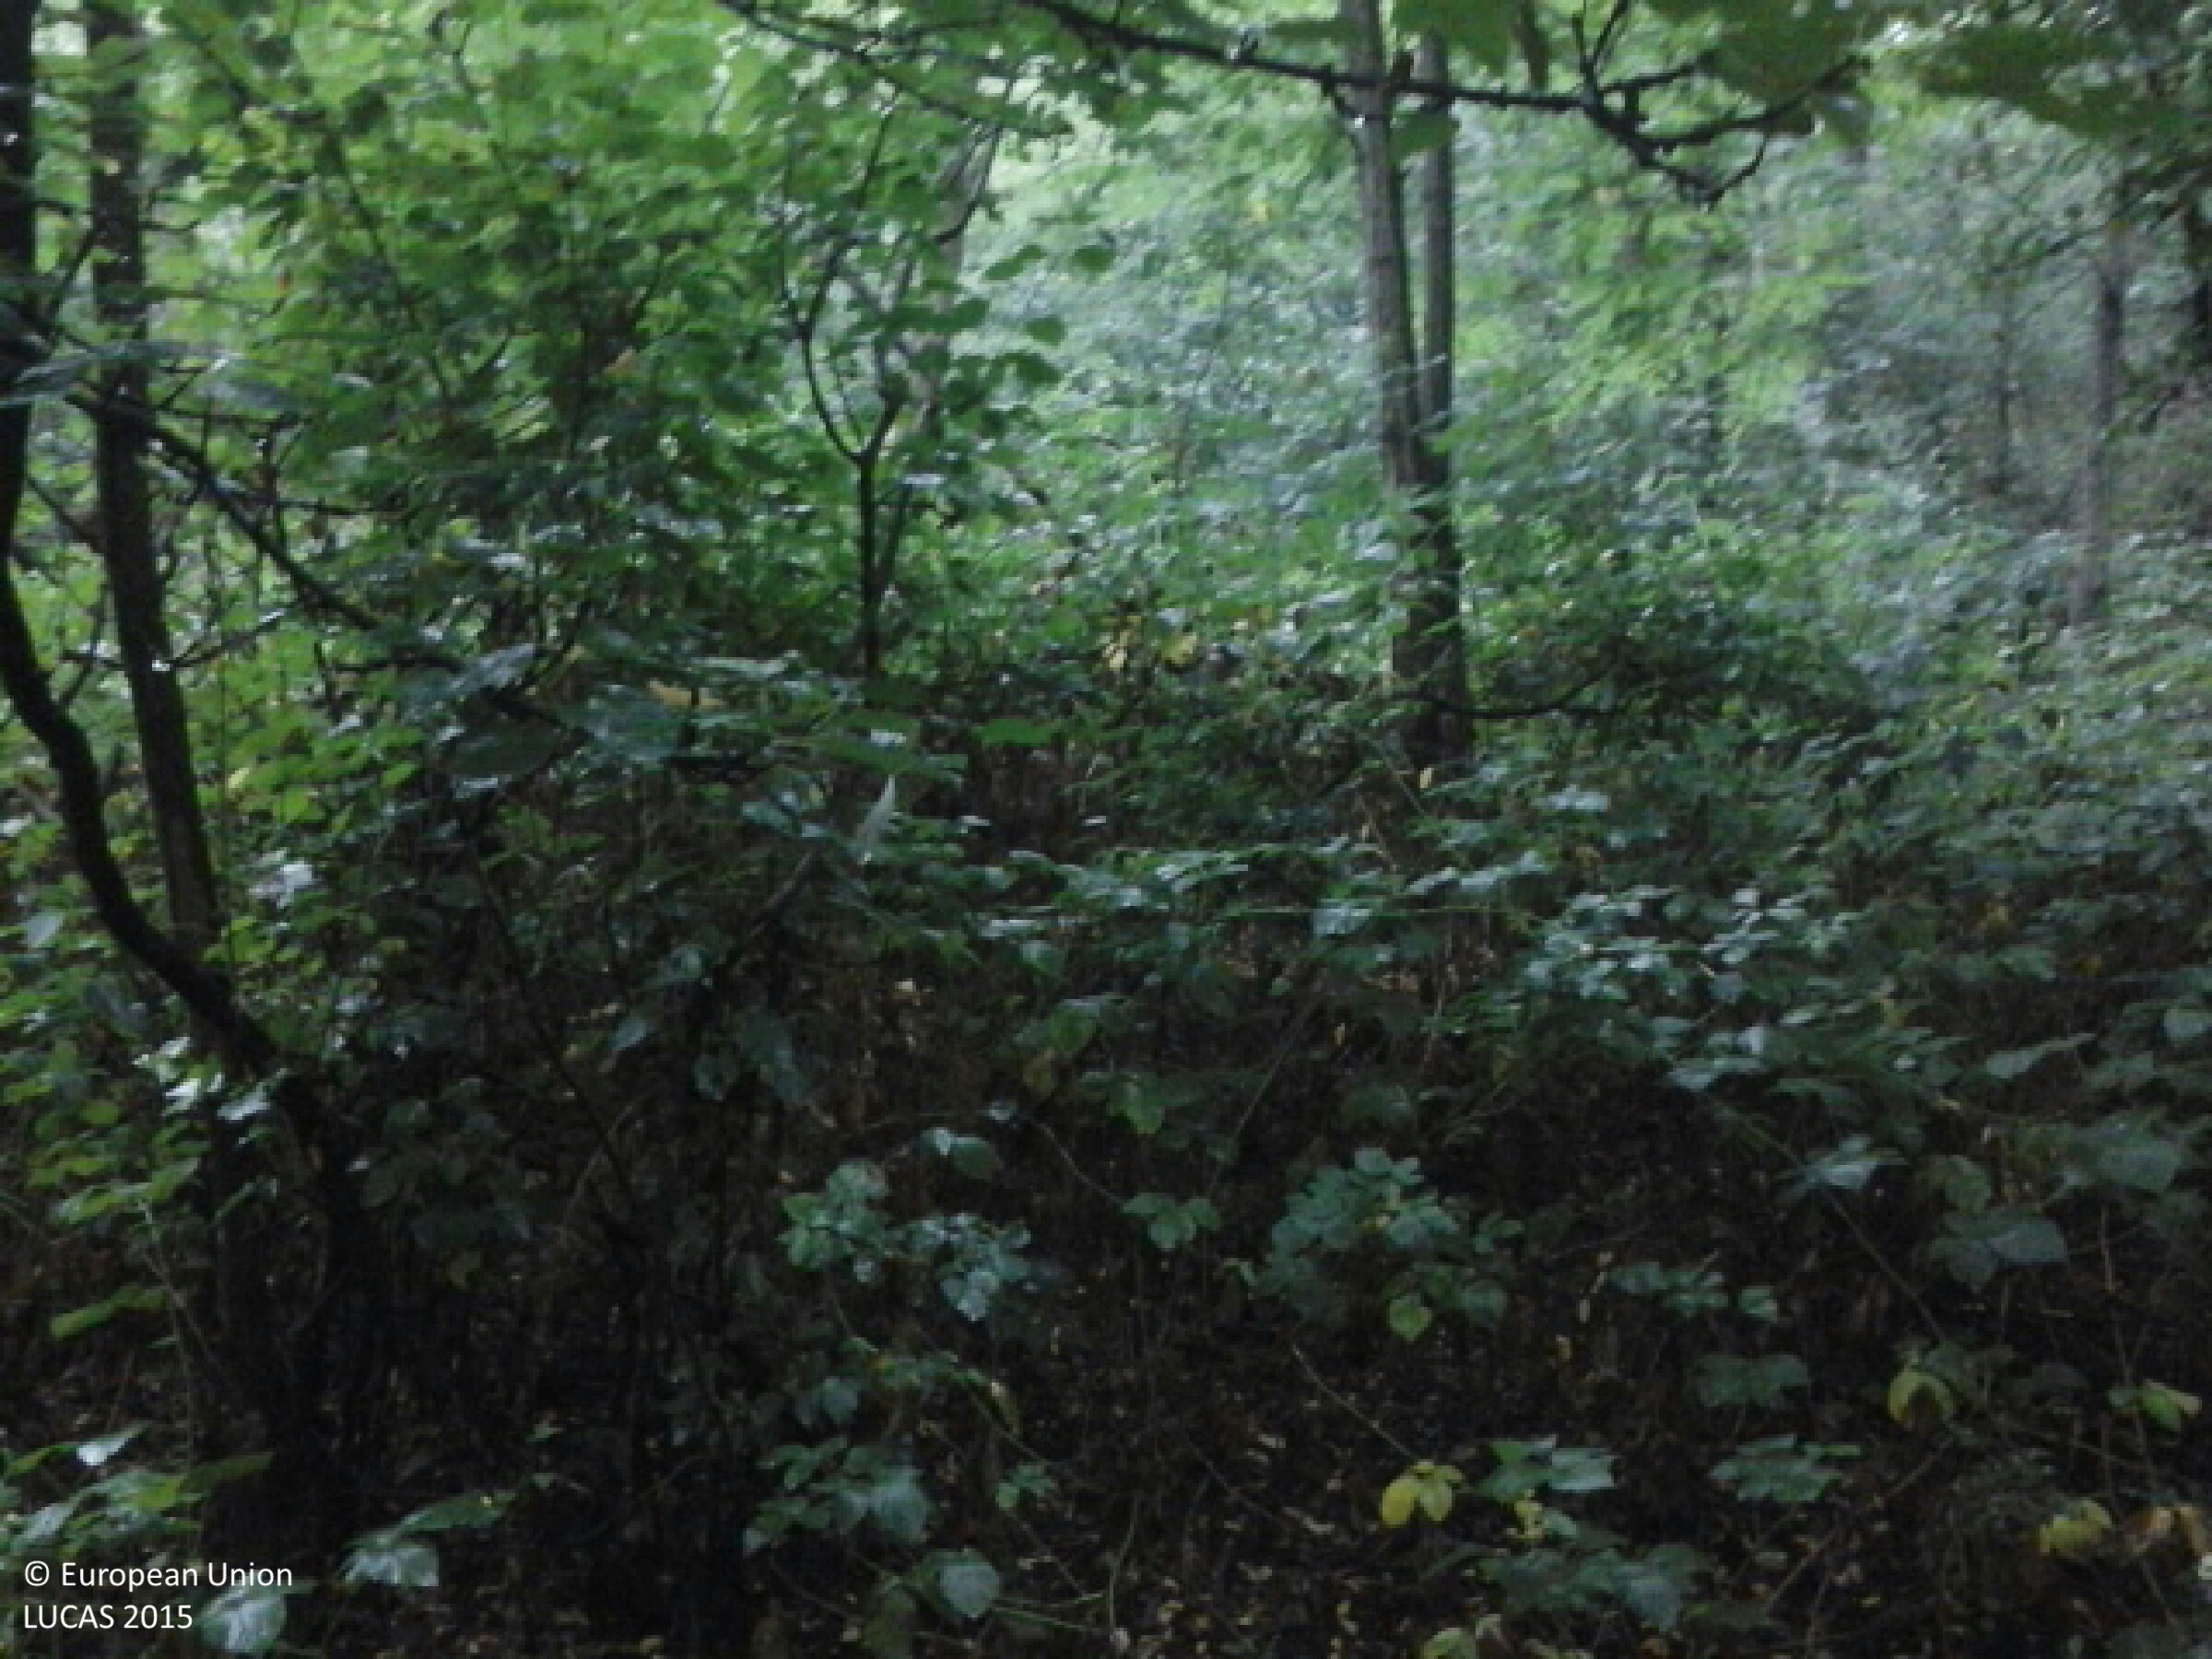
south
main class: Woodland
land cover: Broadleaved woodland
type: mesophytic deciduous forest
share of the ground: > 75 %
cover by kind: broadleaved forest trees 95 %, shrubs 5 %
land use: Forestry
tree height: > 5 m
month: July
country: HU
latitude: 48.5031
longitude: 21.5658
